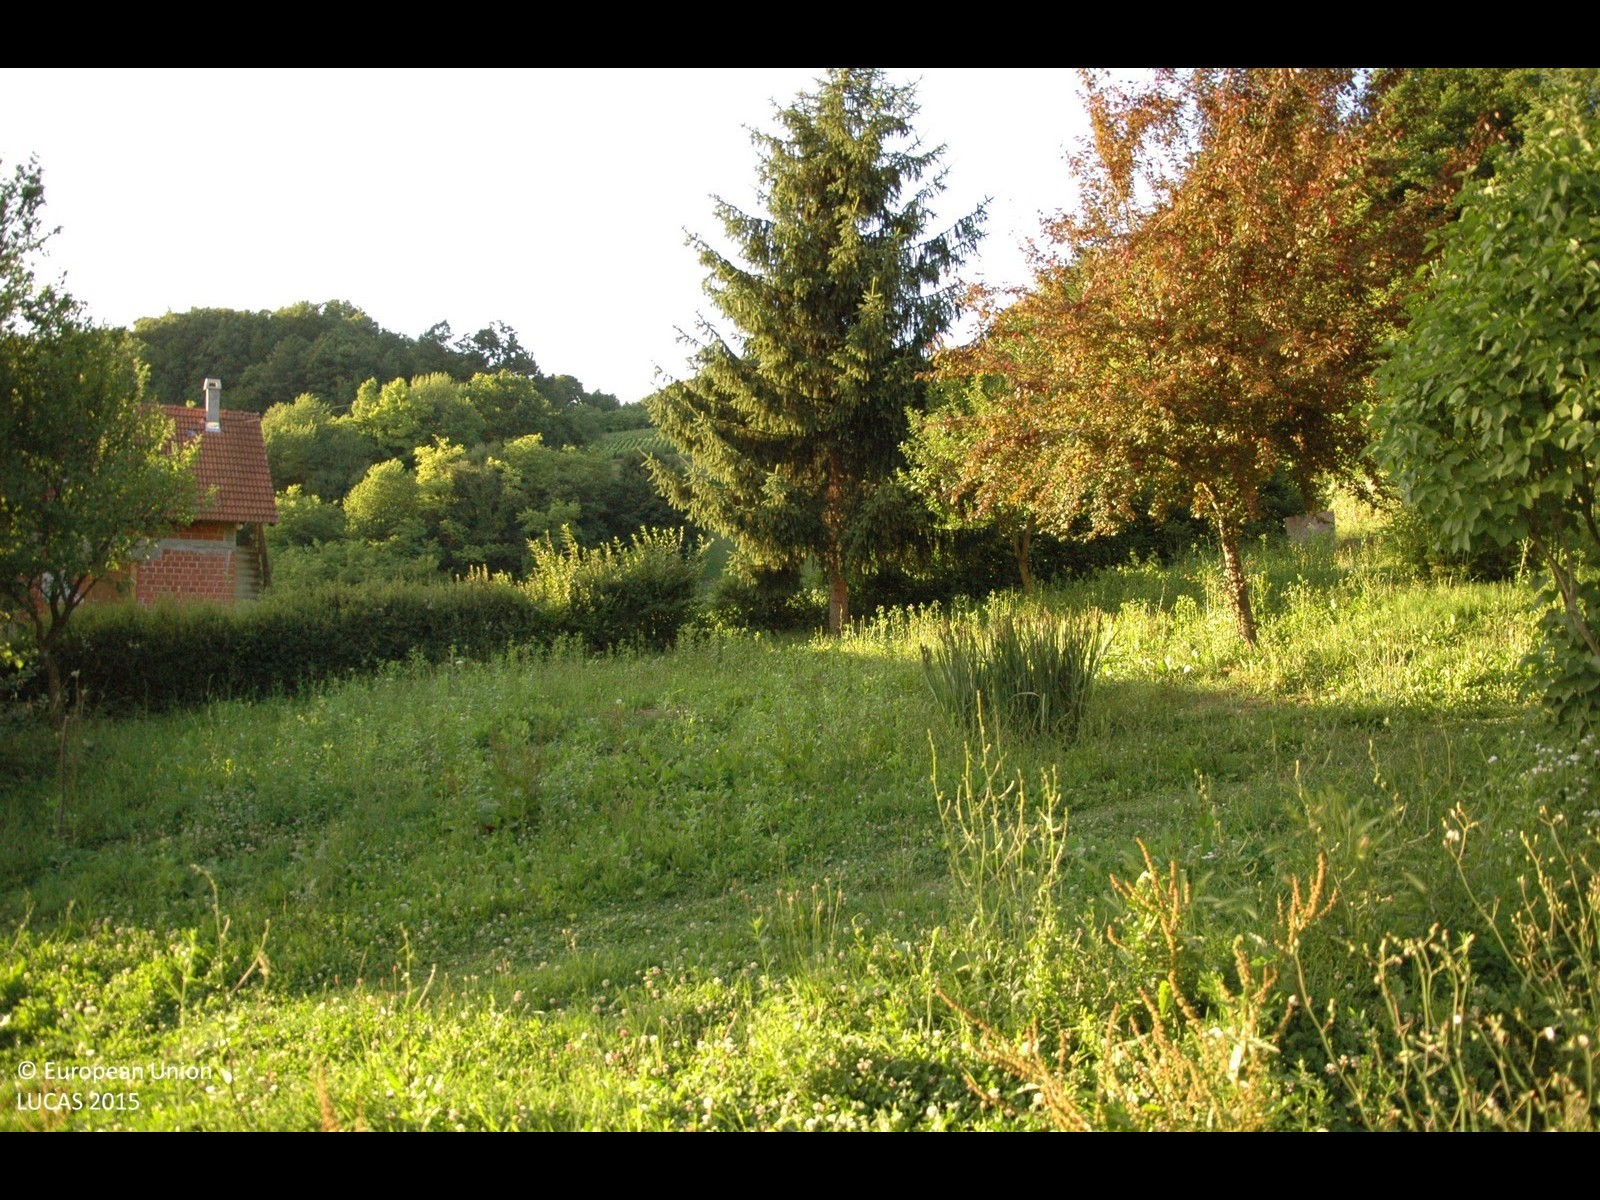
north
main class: Grassland
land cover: Grassland with sparse tree/shrub cover
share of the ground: > 75 %
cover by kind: herbaceous plants 95 %, broadleaved forest trees 5 %
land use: Residential
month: June
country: HR
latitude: 46.0687
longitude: 15.7772
